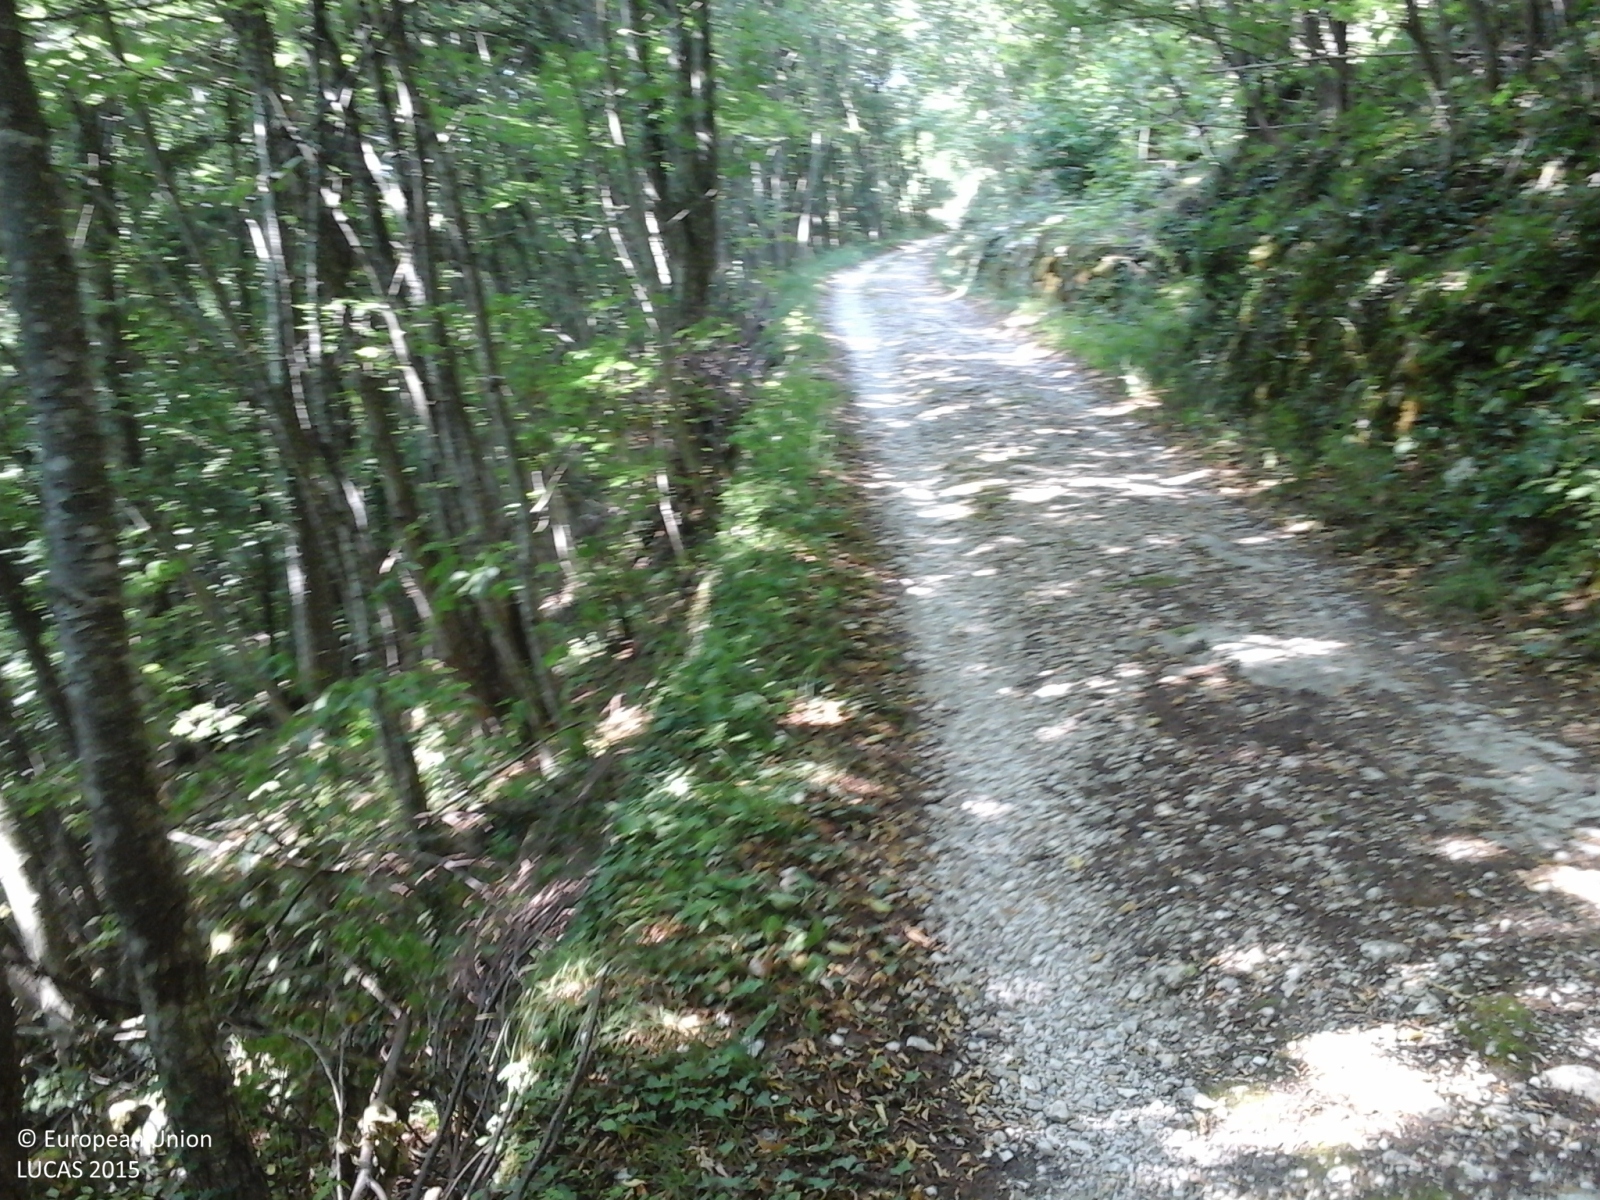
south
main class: Woodland
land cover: Broadleaved woodland
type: mountainous beech forest
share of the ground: > 75 %
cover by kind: broadleaved forest trees 100 %
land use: Forestry
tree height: > 5 m
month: July
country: IT
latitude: 45.6252
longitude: 11.0628
